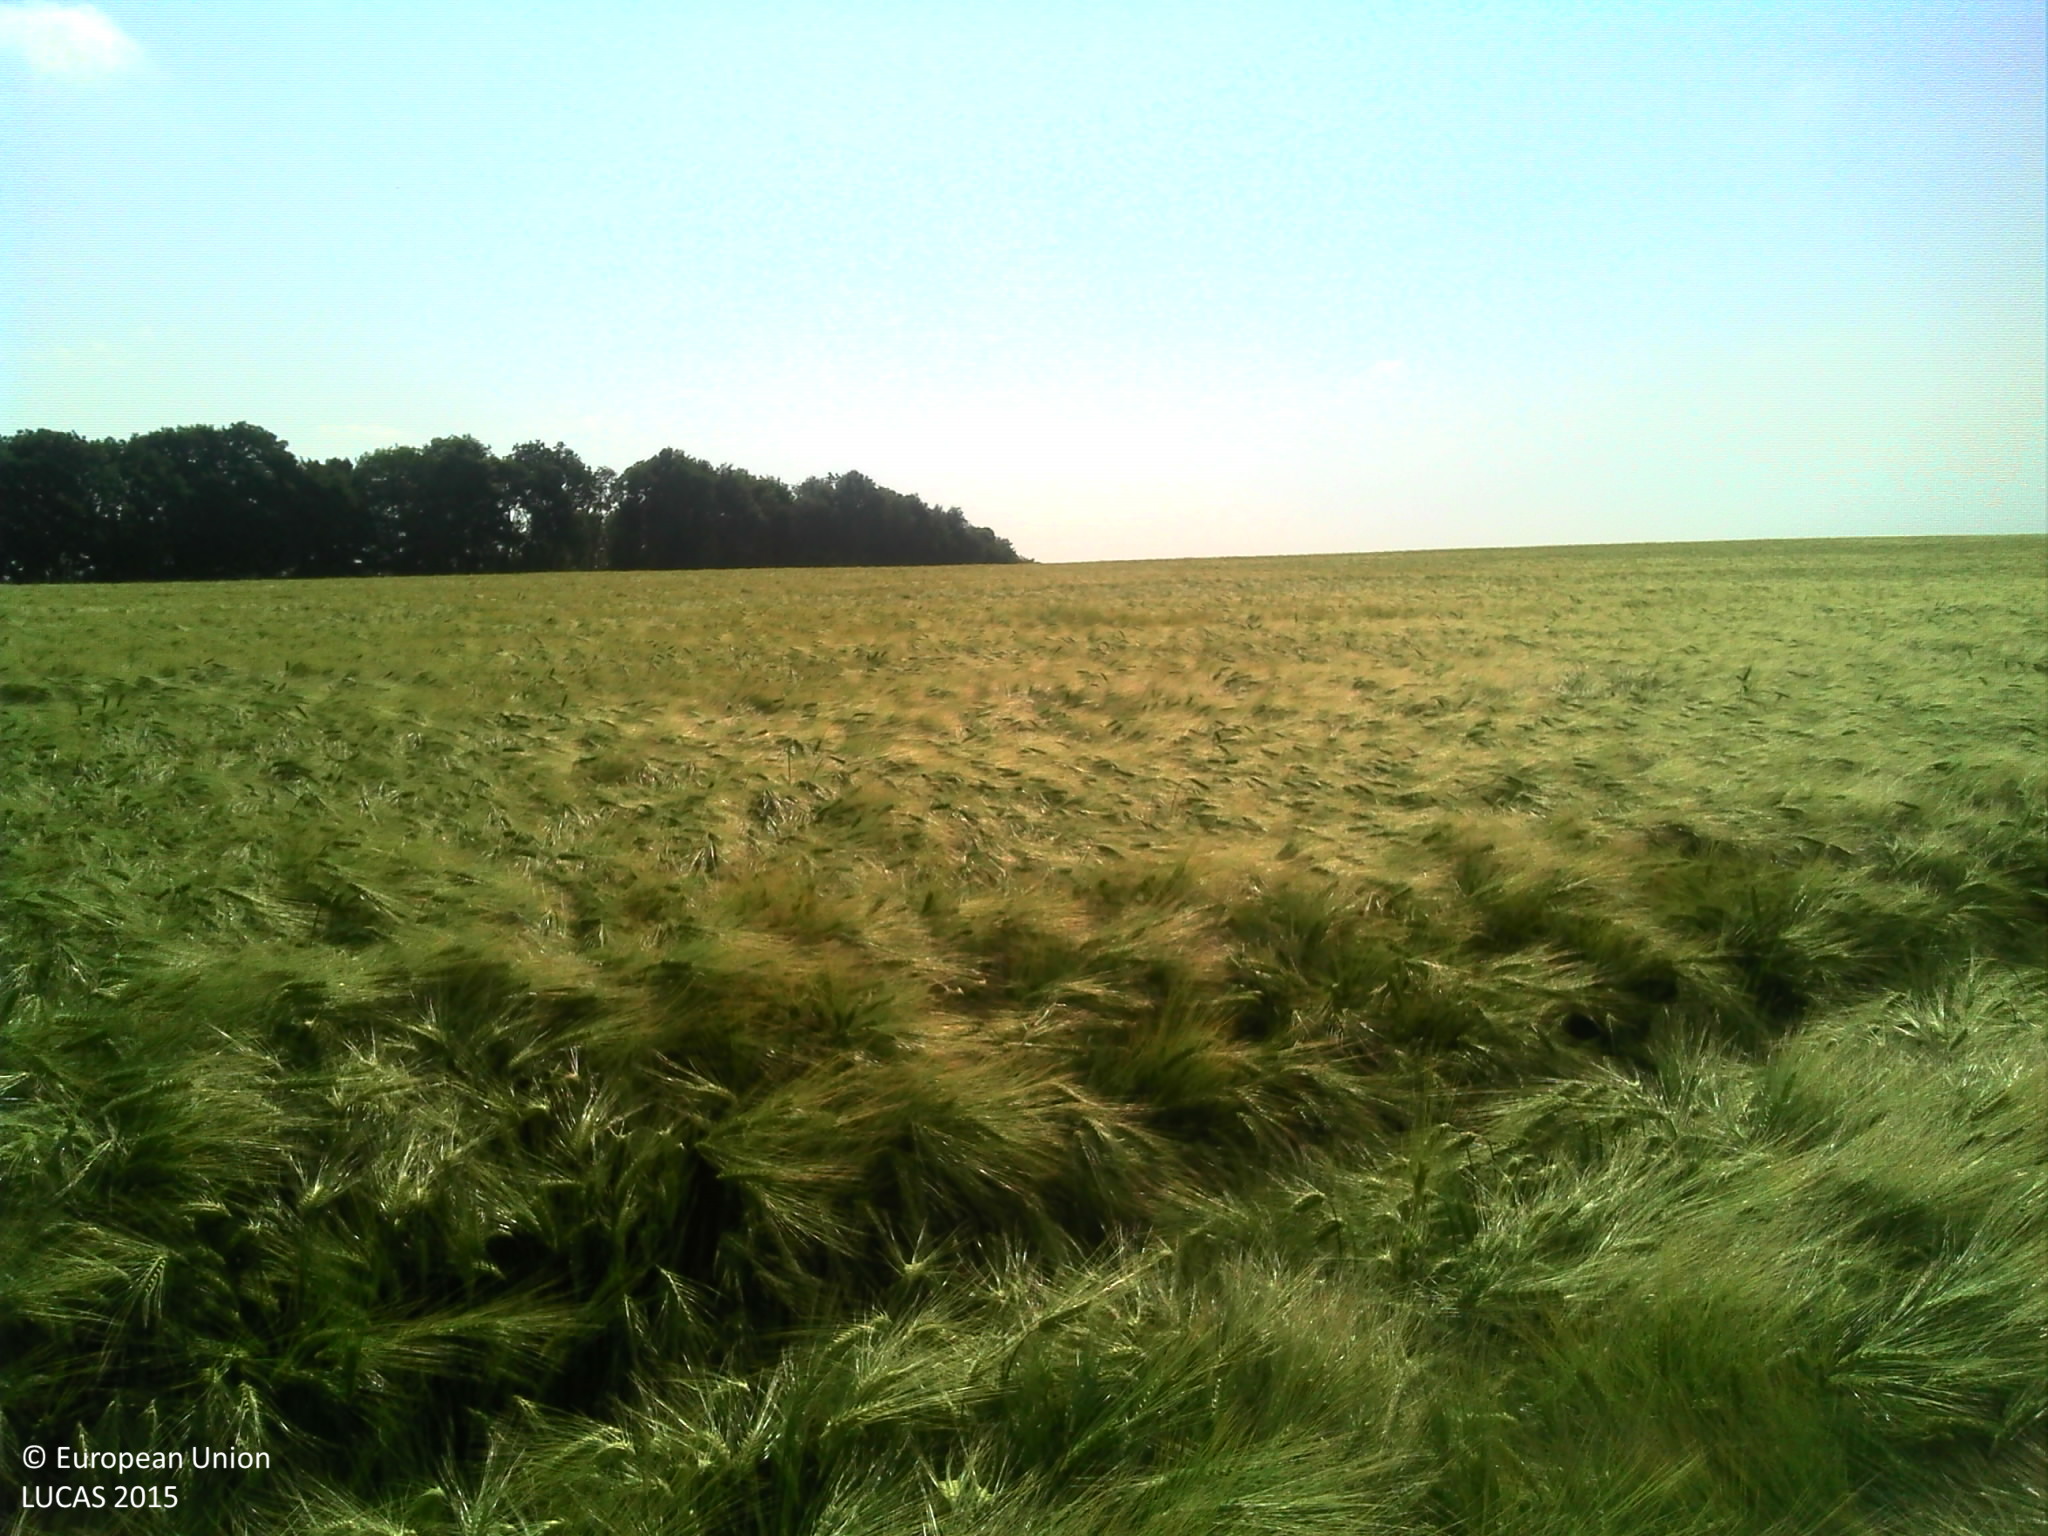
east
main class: Cropland
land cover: Barley
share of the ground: > 75 %
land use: Agriculture (excluding fallow land and kitchen gardens)
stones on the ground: < 10 %
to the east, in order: Barley; Grass margins; Paved roads, cycling and walking lanes; Grass margins; Rape and turnip rape; Broadleaved woodland
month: June
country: FR
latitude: 49.8833
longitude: 4.0240
